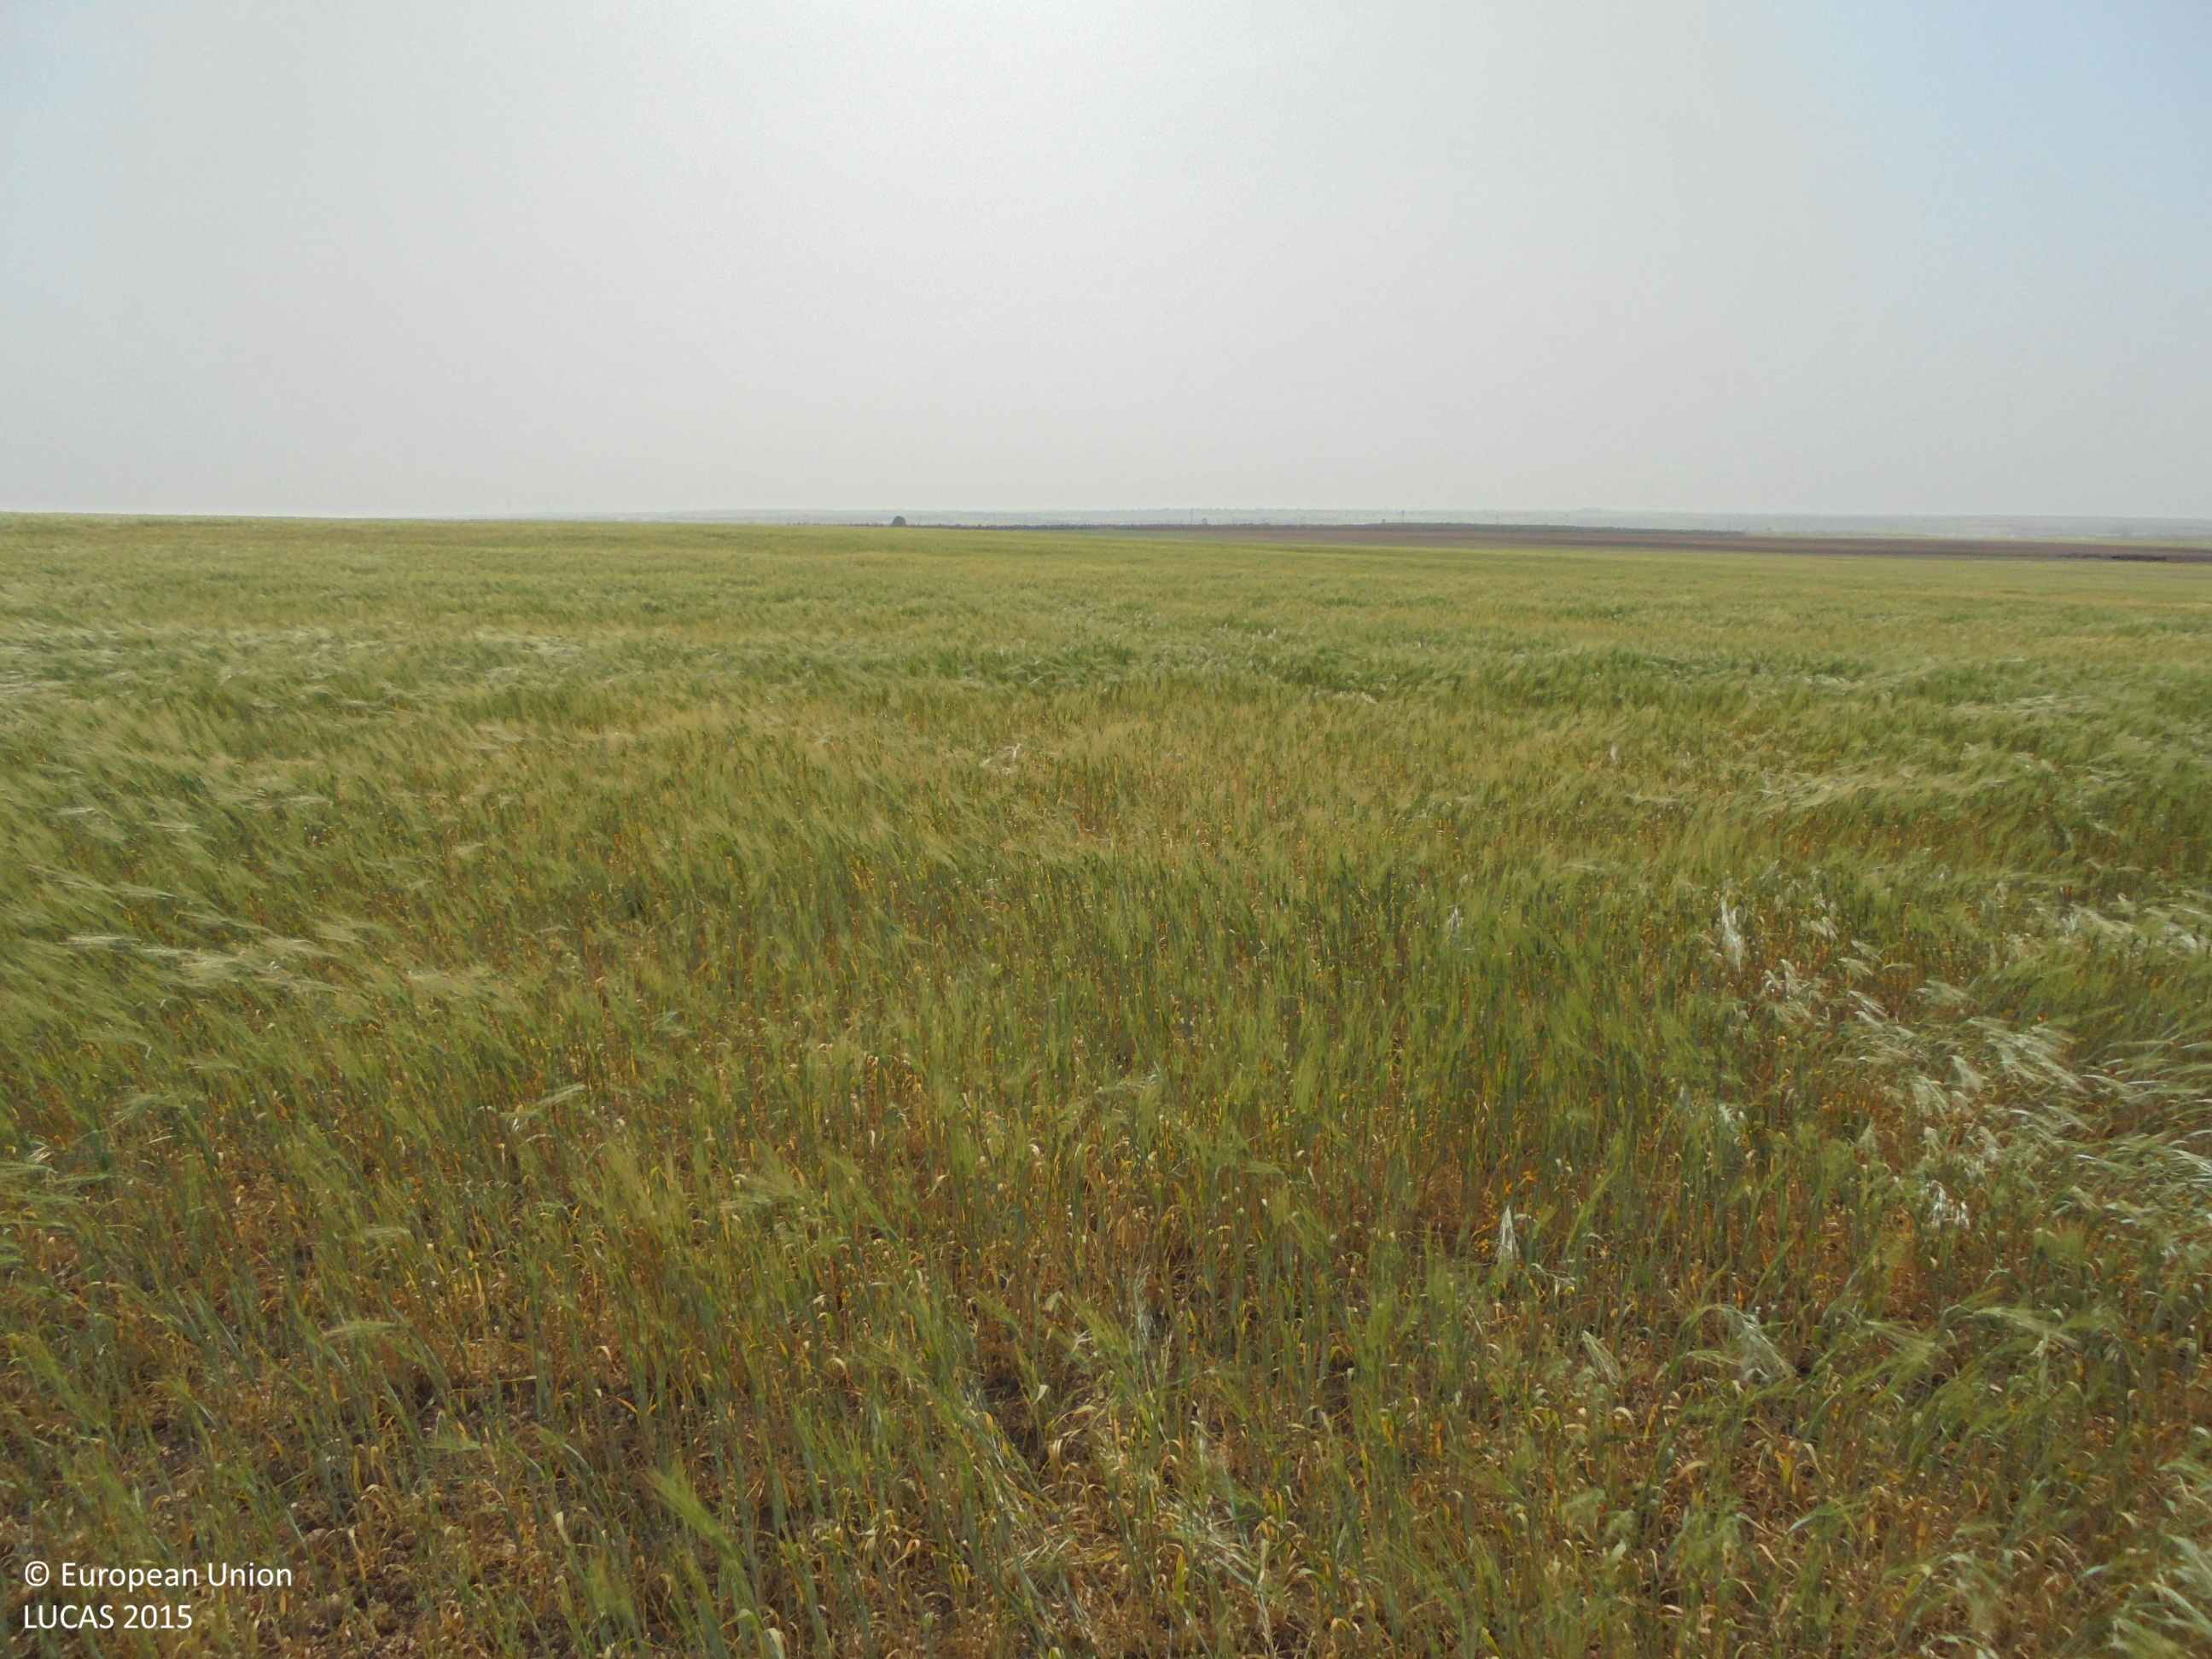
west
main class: Cropland
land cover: Barley
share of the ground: 25 - 50 %
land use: Agriculture (excluding fallow land and kitchen gardens)
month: May
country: ES
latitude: 39.0814
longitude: -1.6176
